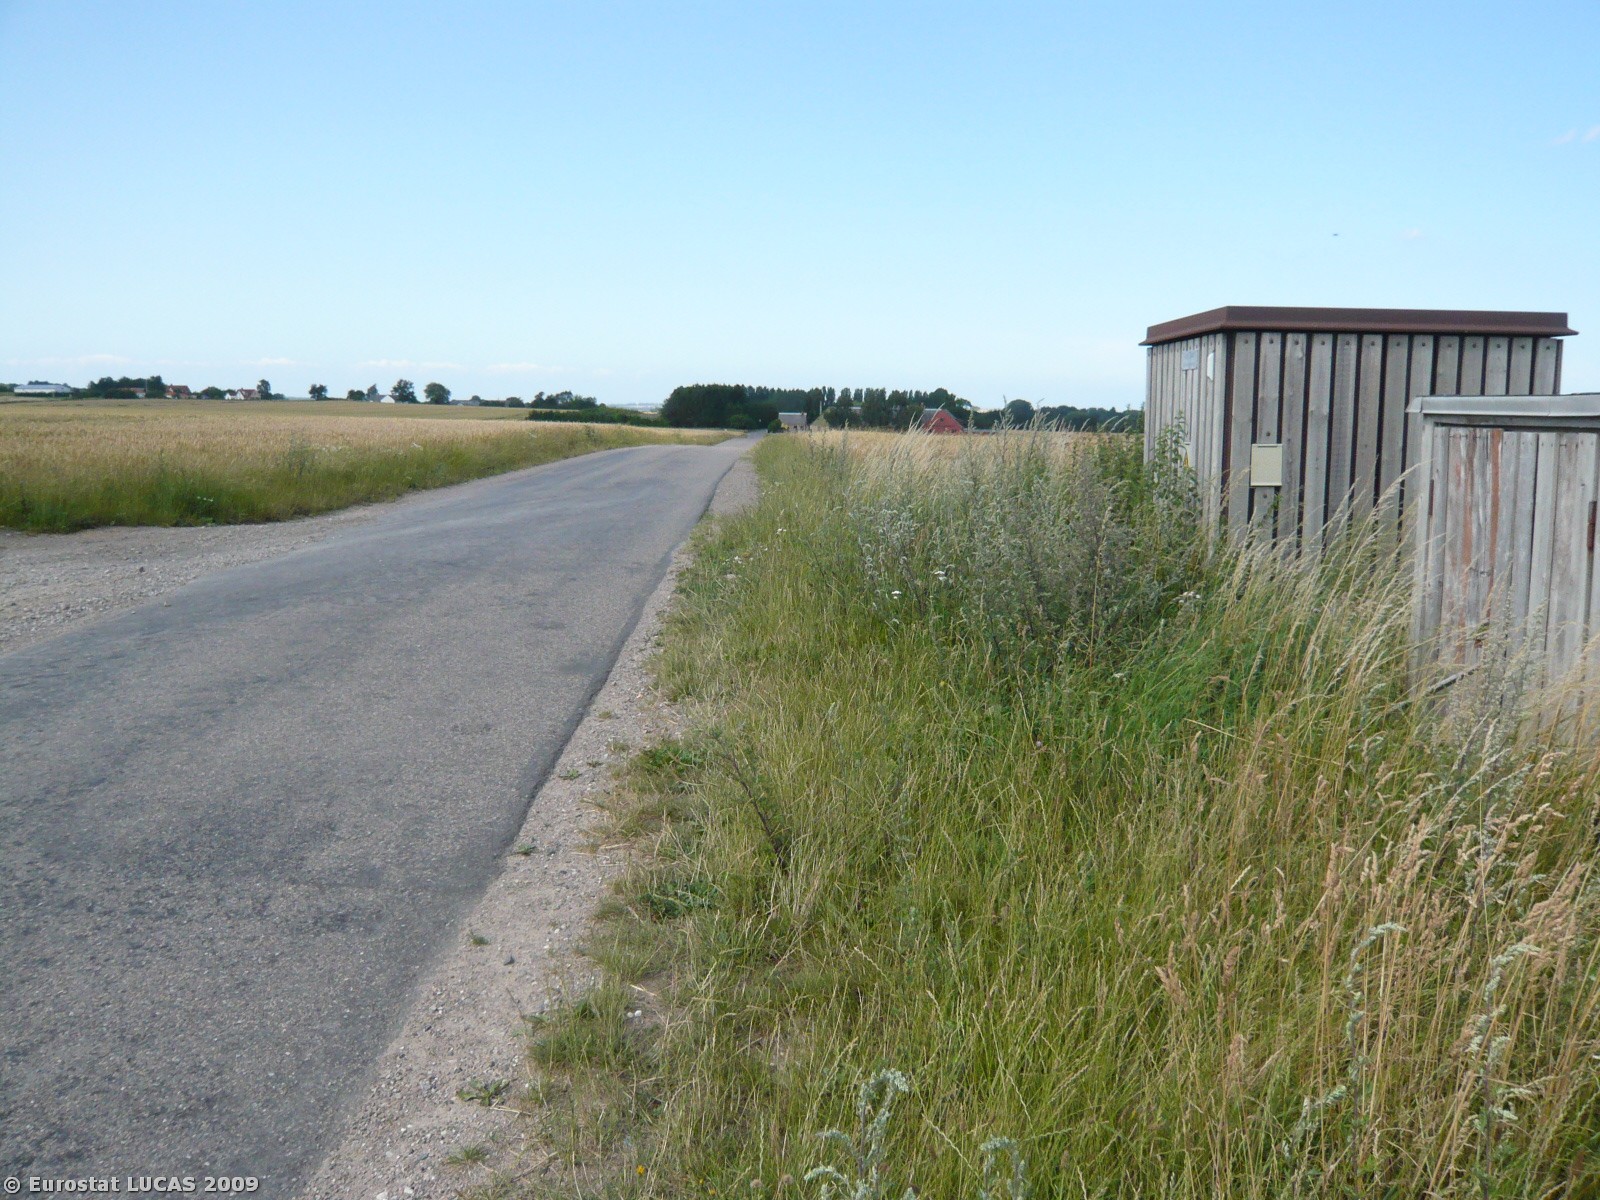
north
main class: Grassland
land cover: Grassland without tree/shrub cover
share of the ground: > 75 %
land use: Agriculture (excluding fallow land and kitchen gardens)
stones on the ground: < 10 %
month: July
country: DK
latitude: 55.7450
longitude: 11.7029
